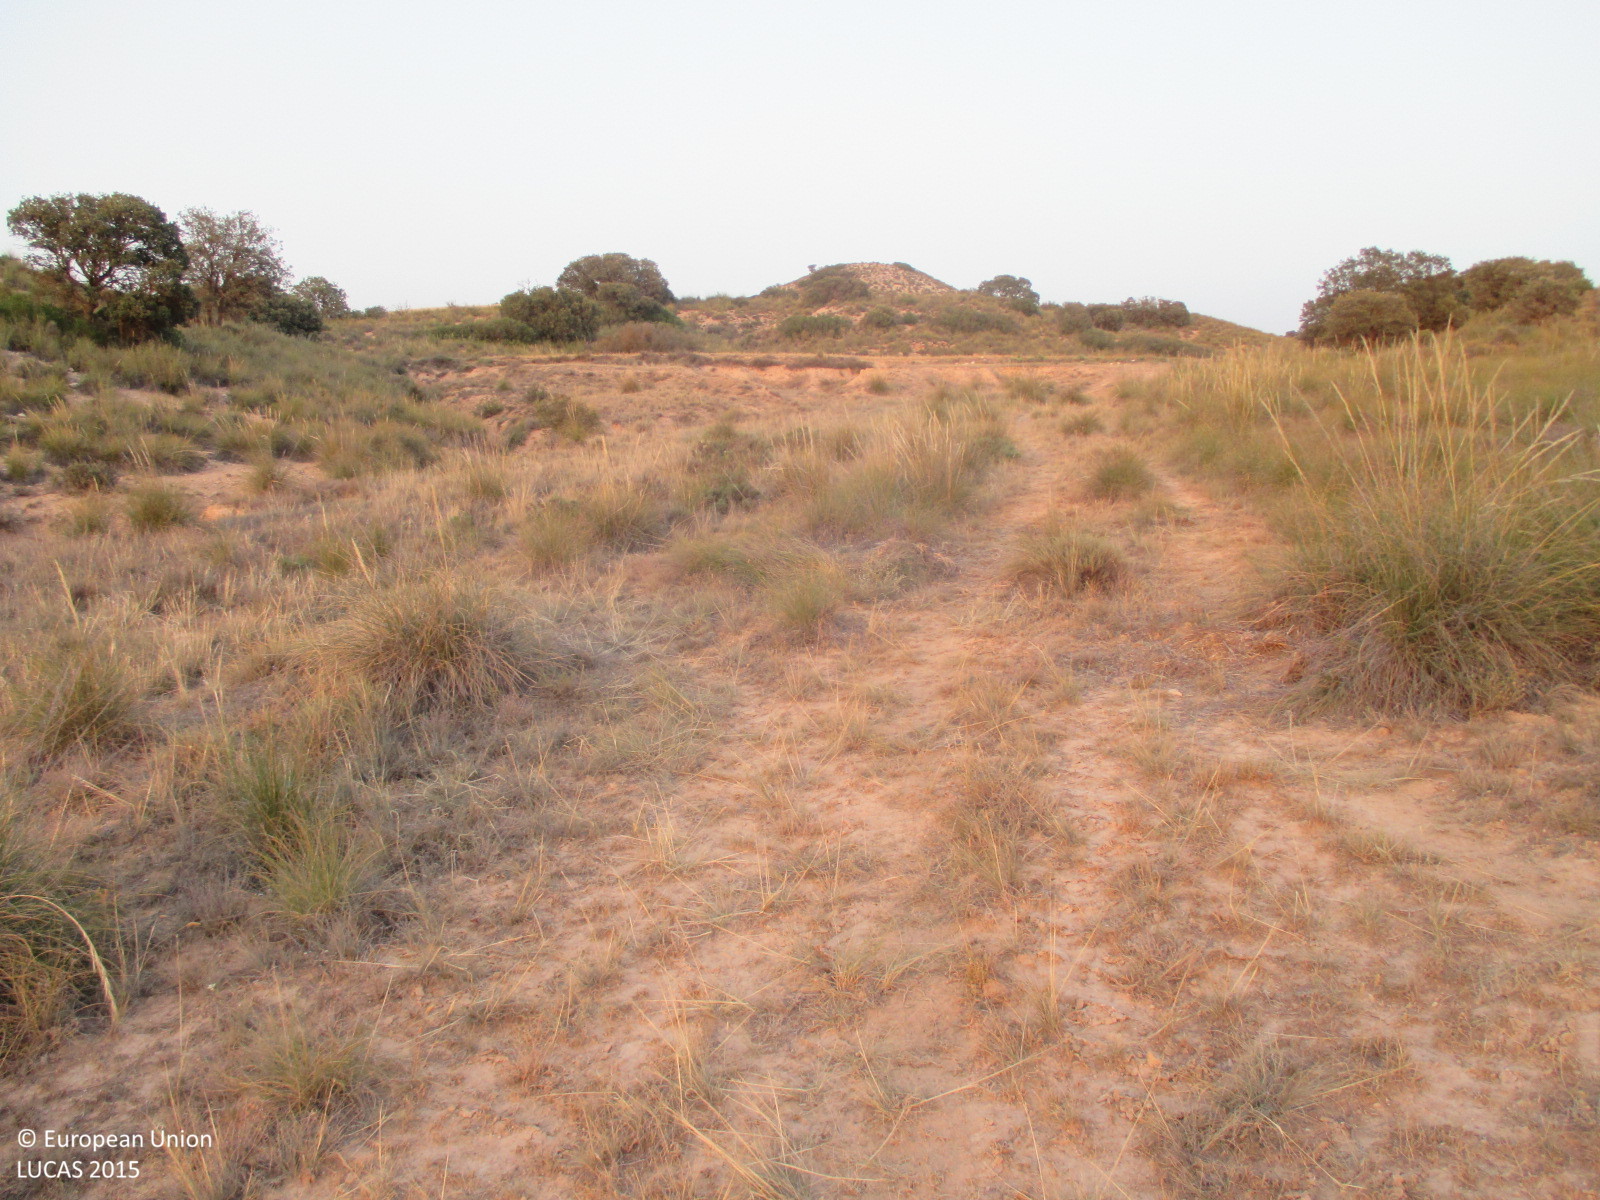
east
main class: Grassland
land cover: Grassland without tree/shrub cover
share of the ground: > 75 %
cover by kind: herbaceous plants 100 %
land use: Semi-natural and natural areas not in use
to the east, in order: Grassland without tree/shrub cover; Rivers and streams; Grassland without tree/shrub cover; Oats; Shrubland without tree cover; Oats
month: June
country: ES
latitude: 37.7637
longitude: -2.3498
